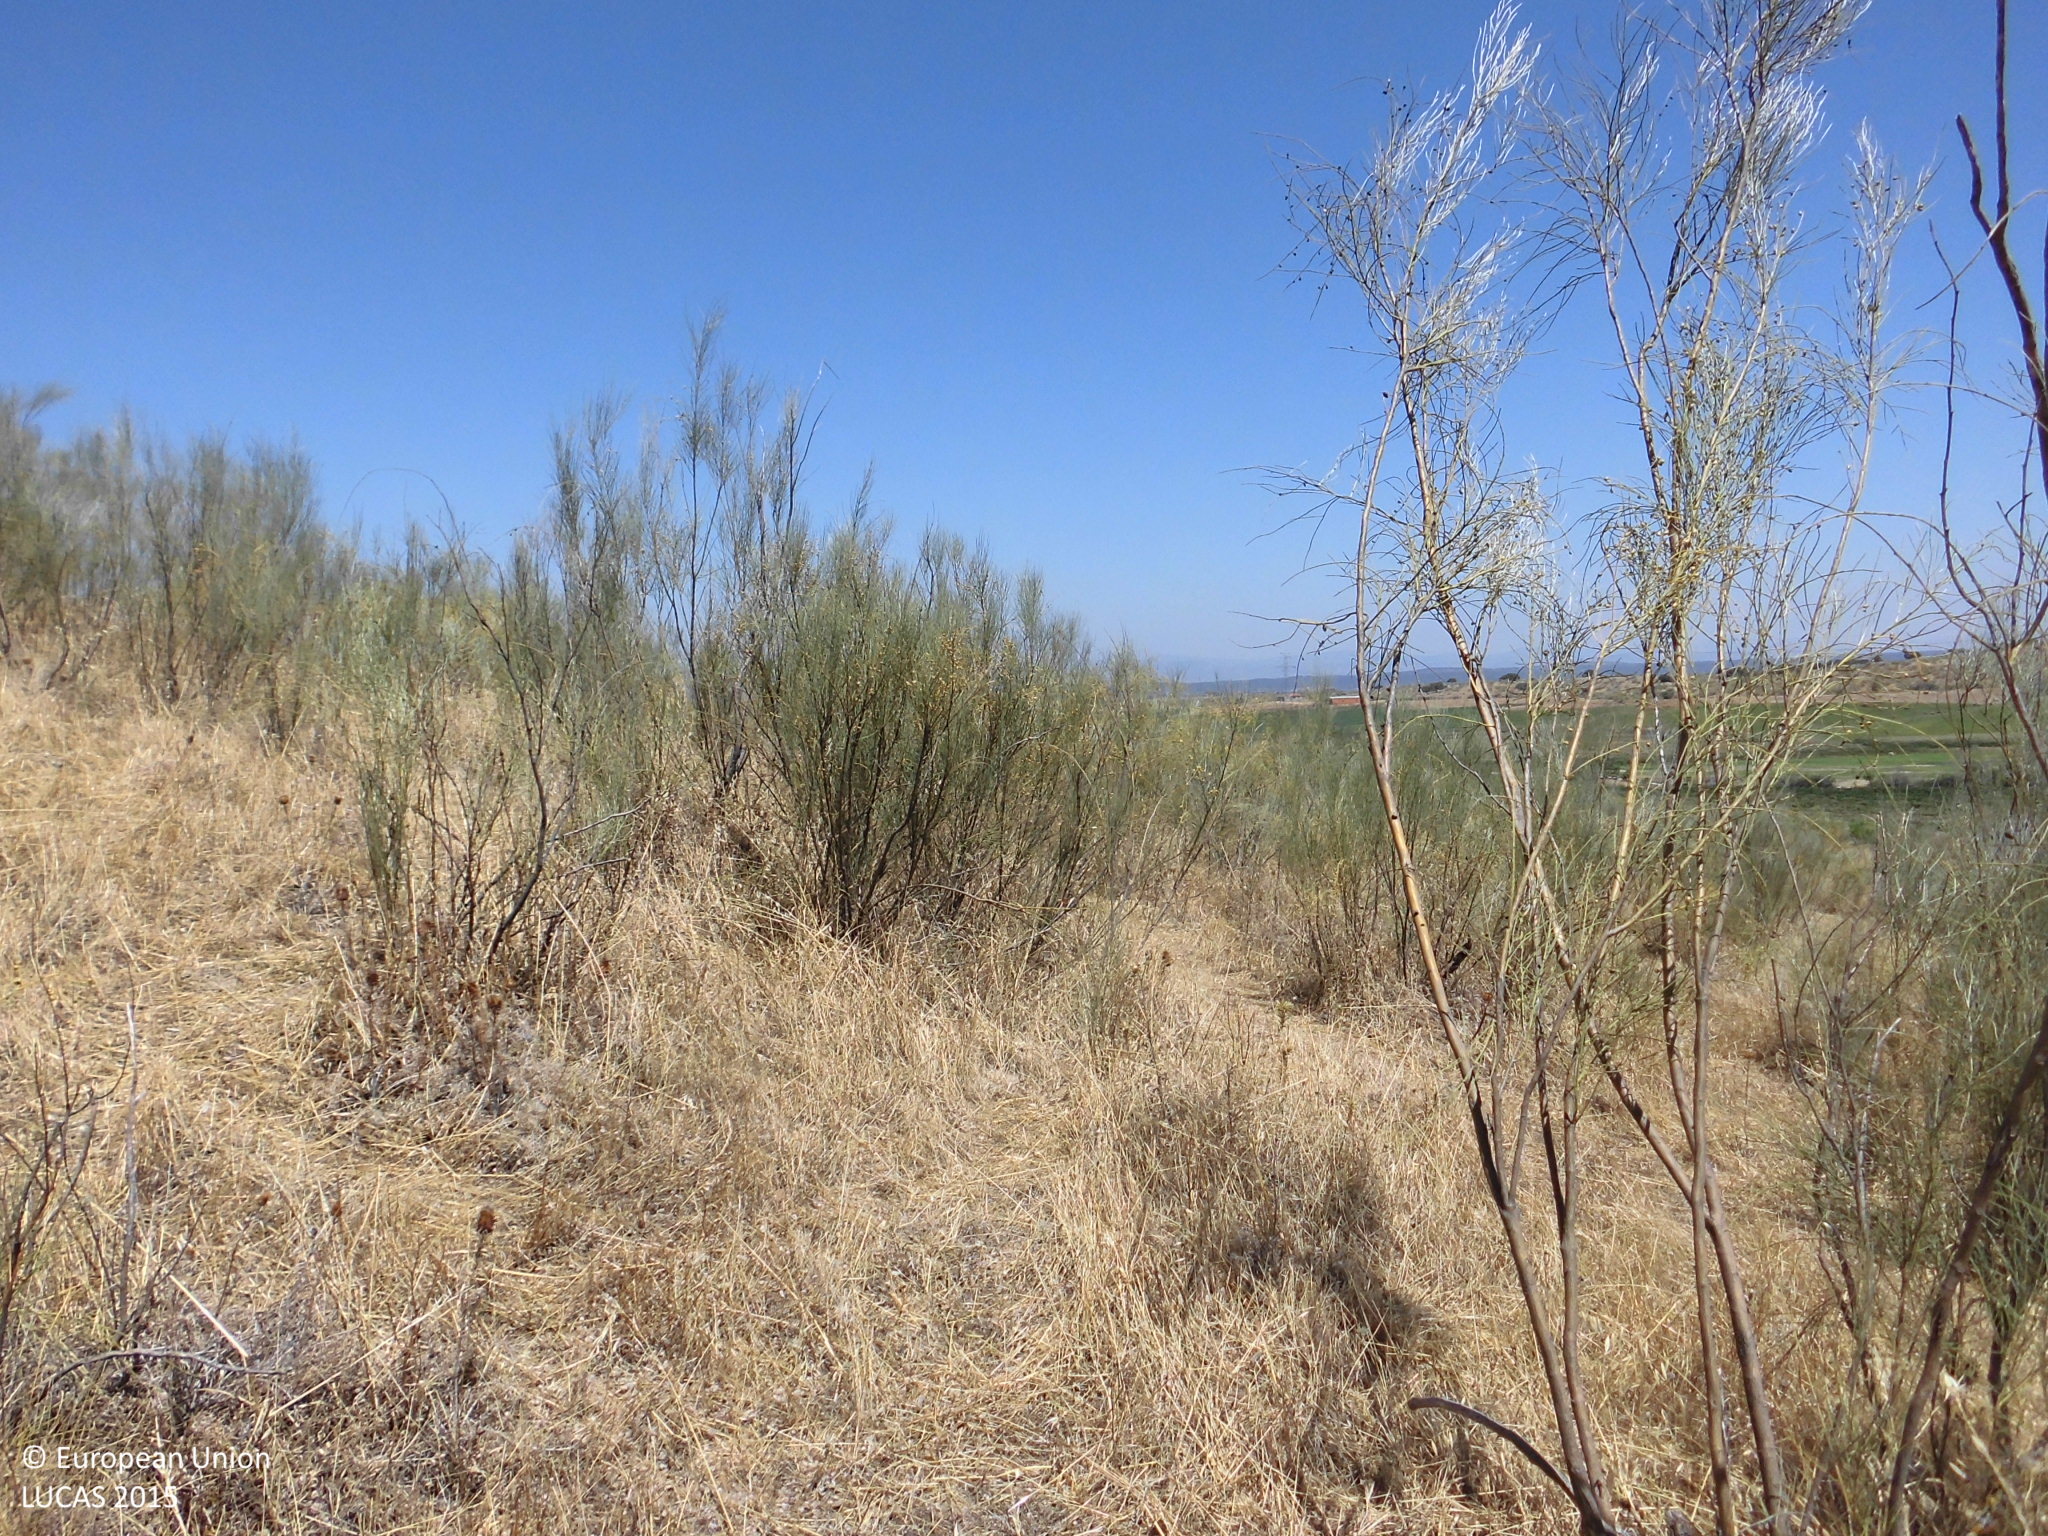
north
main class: Shrubland
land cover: Shrubland without tree cover
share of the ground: 25 - 50 %
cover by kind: herbaceous plants 65 %, shrubs 35 %
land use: Agriculture (excluding fallow land and kitchen gardens)
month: July
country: ES
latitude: 39.9967
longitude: -6.2016
